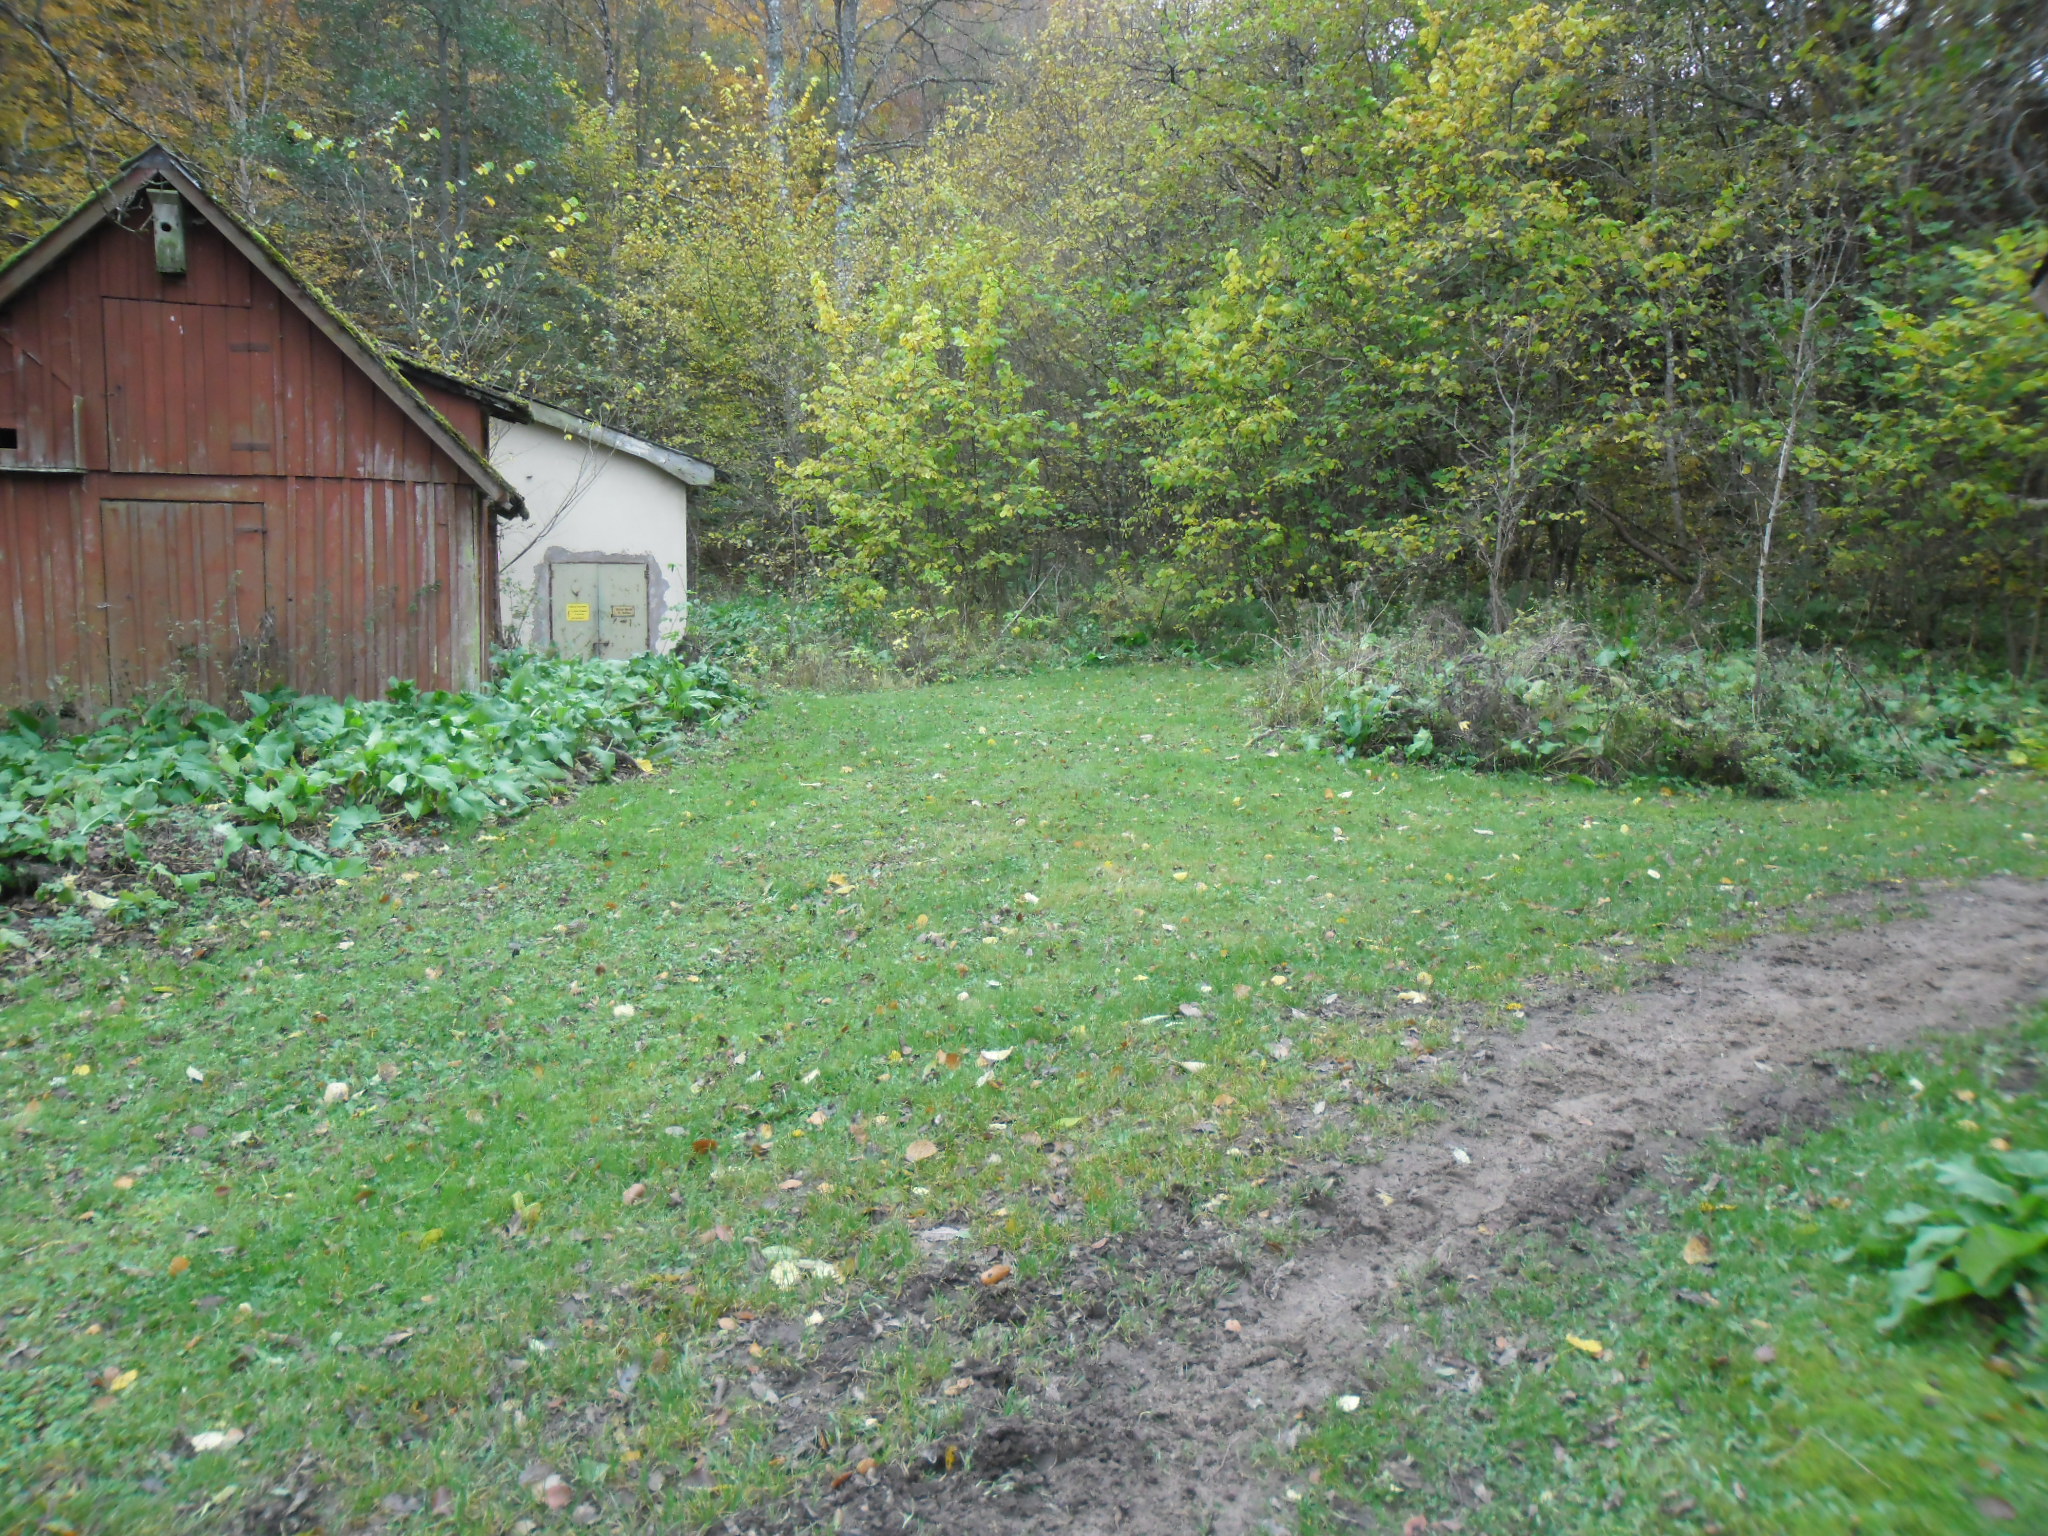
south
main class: Grassland
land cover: Grassland without tree/shrub cover
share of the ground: > 75 %
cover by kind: herbaceous plants 100 %
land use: Amenities, museums, leisure
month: October
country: SE
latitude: 56.0982
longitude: 13.7110
